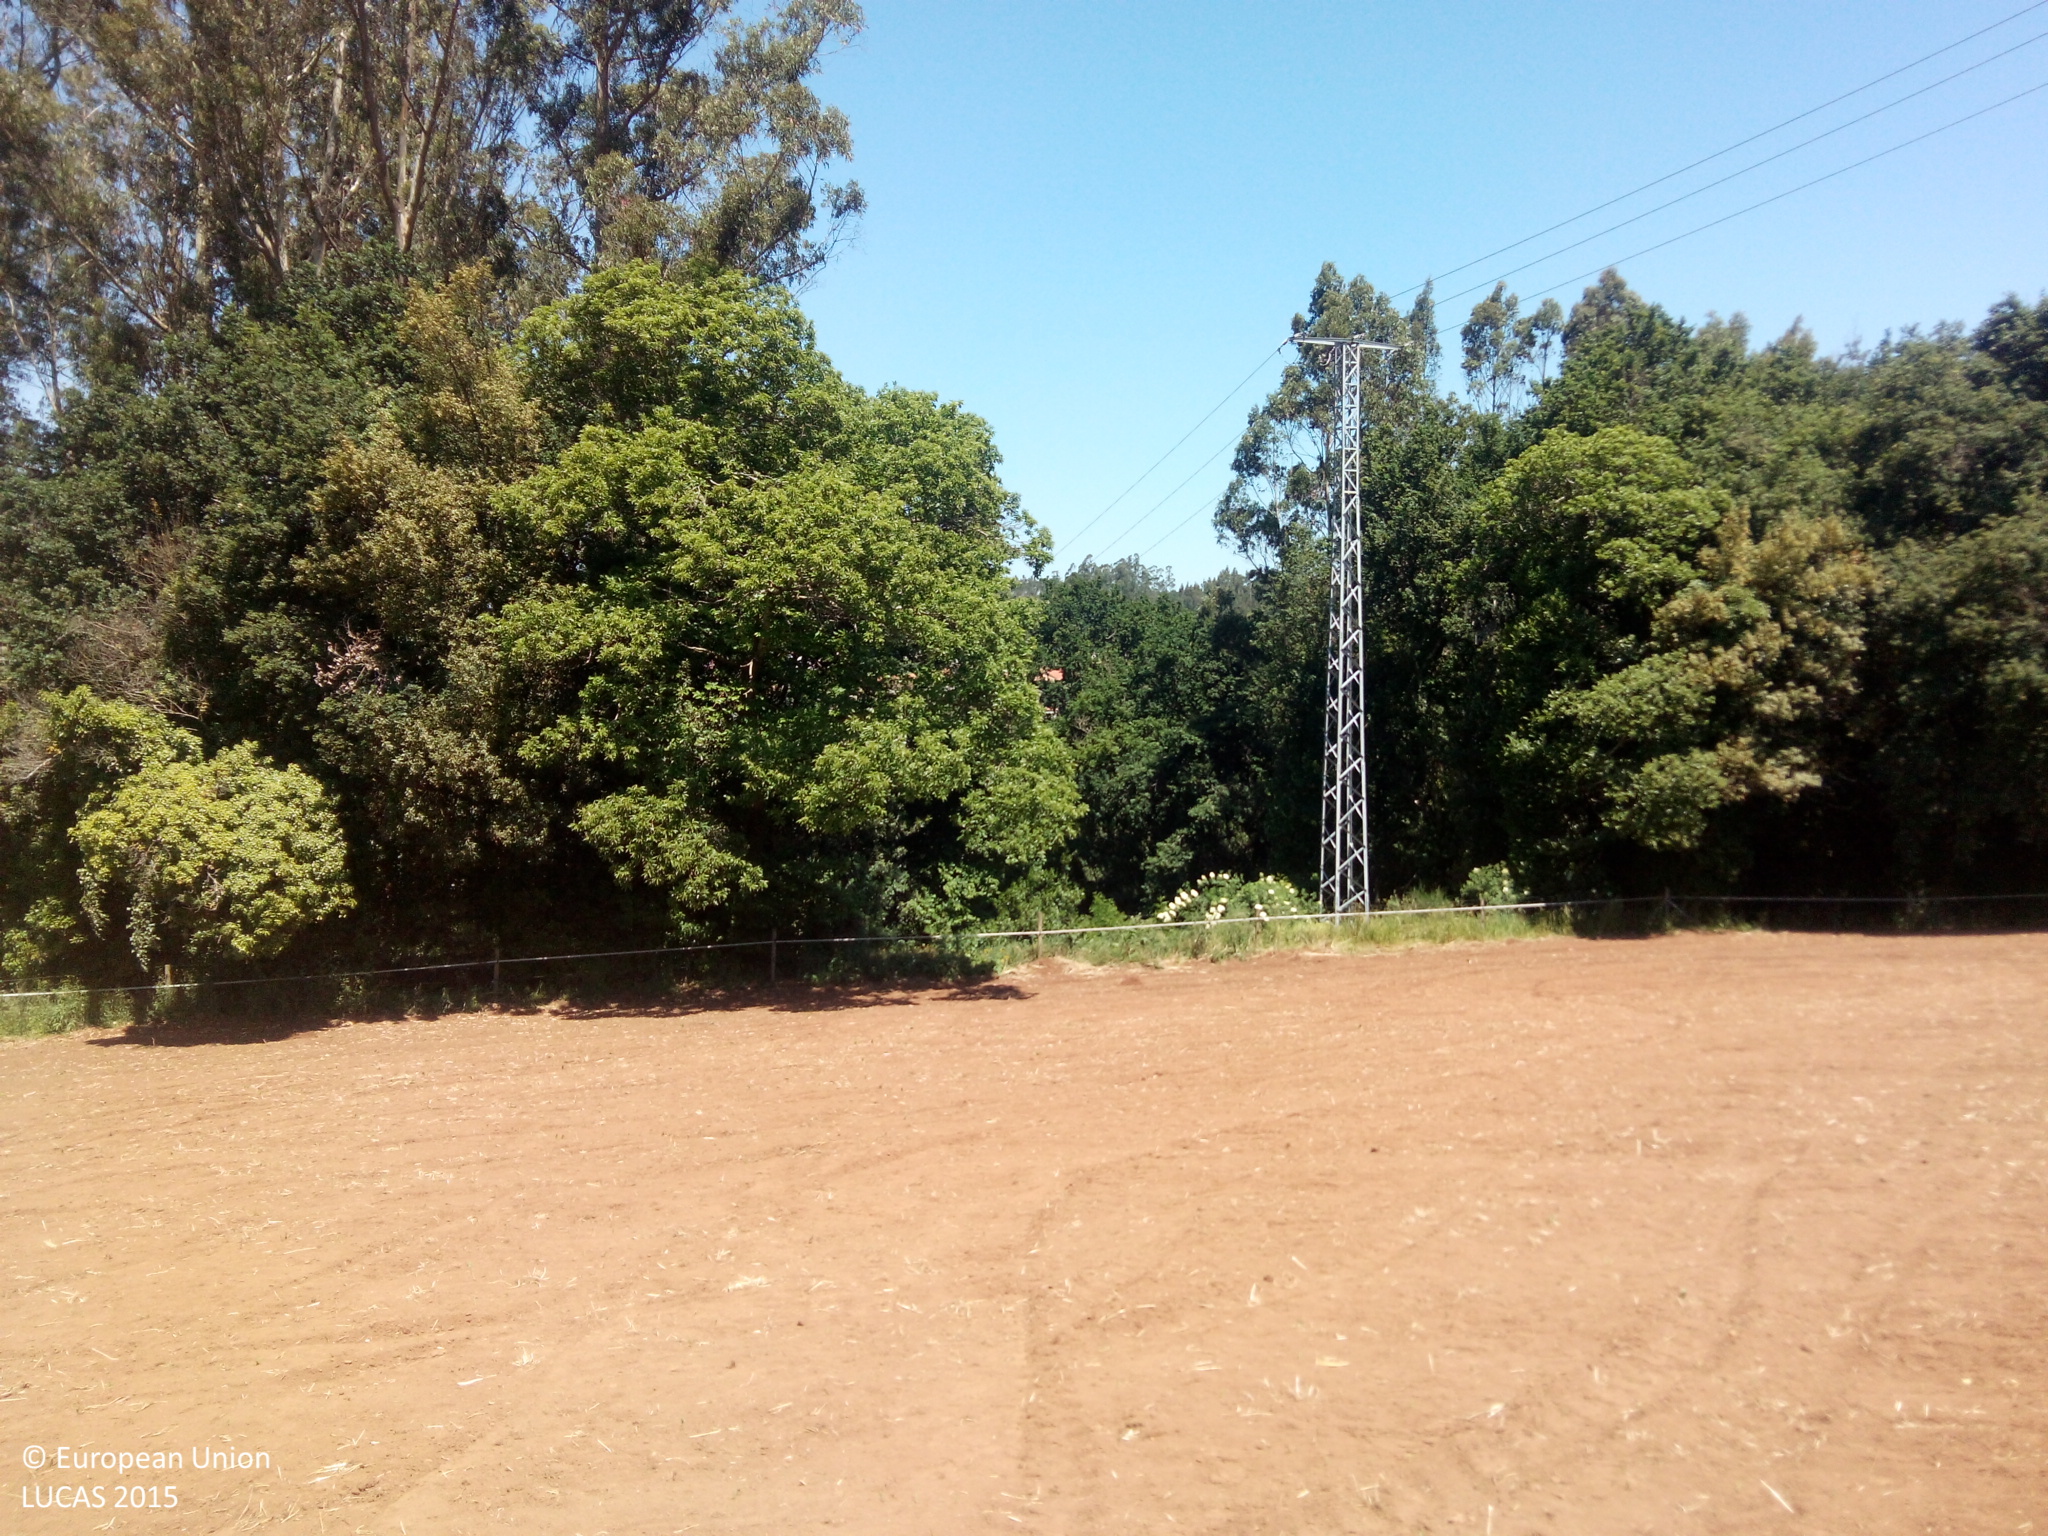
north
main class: Cropland
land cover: Maize
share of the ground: < 10 %
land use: Agriculture (excluding fallow land and kitchen gardens)
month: May
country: ES
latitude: 42.8239
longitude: -8.4615
